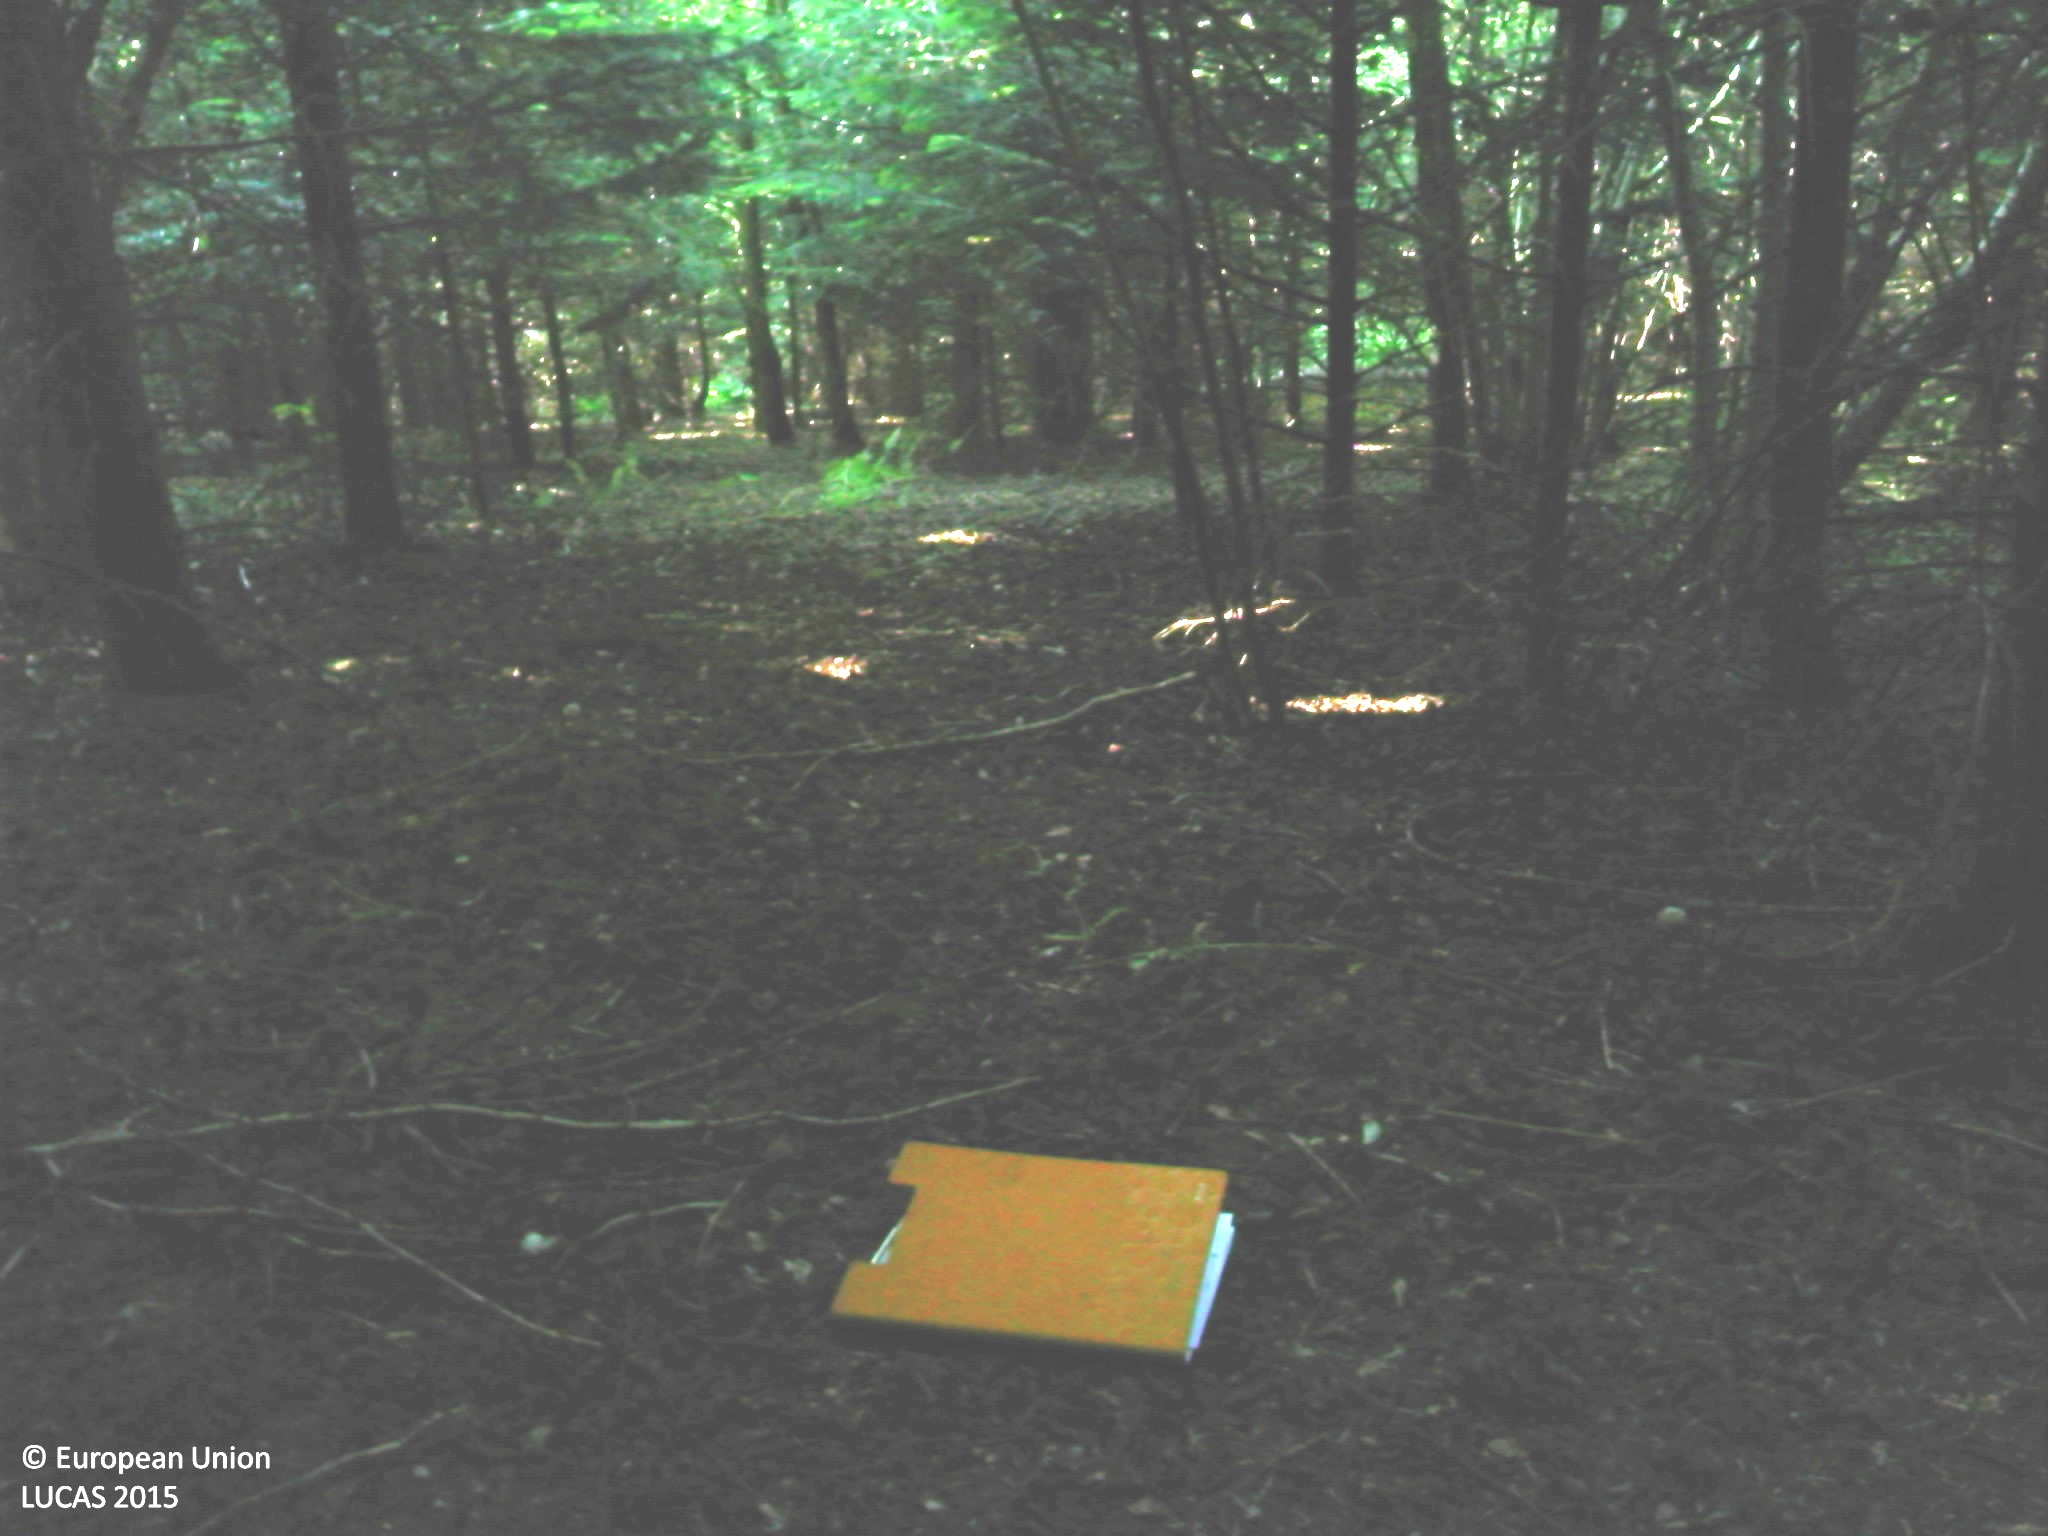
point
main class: Woodland
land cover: Spruce dominated coniferous woodland
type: exotic forest
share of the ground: > 75 %
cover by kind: coniferous forest trees 100 %
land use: Forestry
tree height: > 5 m
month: July
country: FR
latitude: 47.1173
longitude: 3.9225
